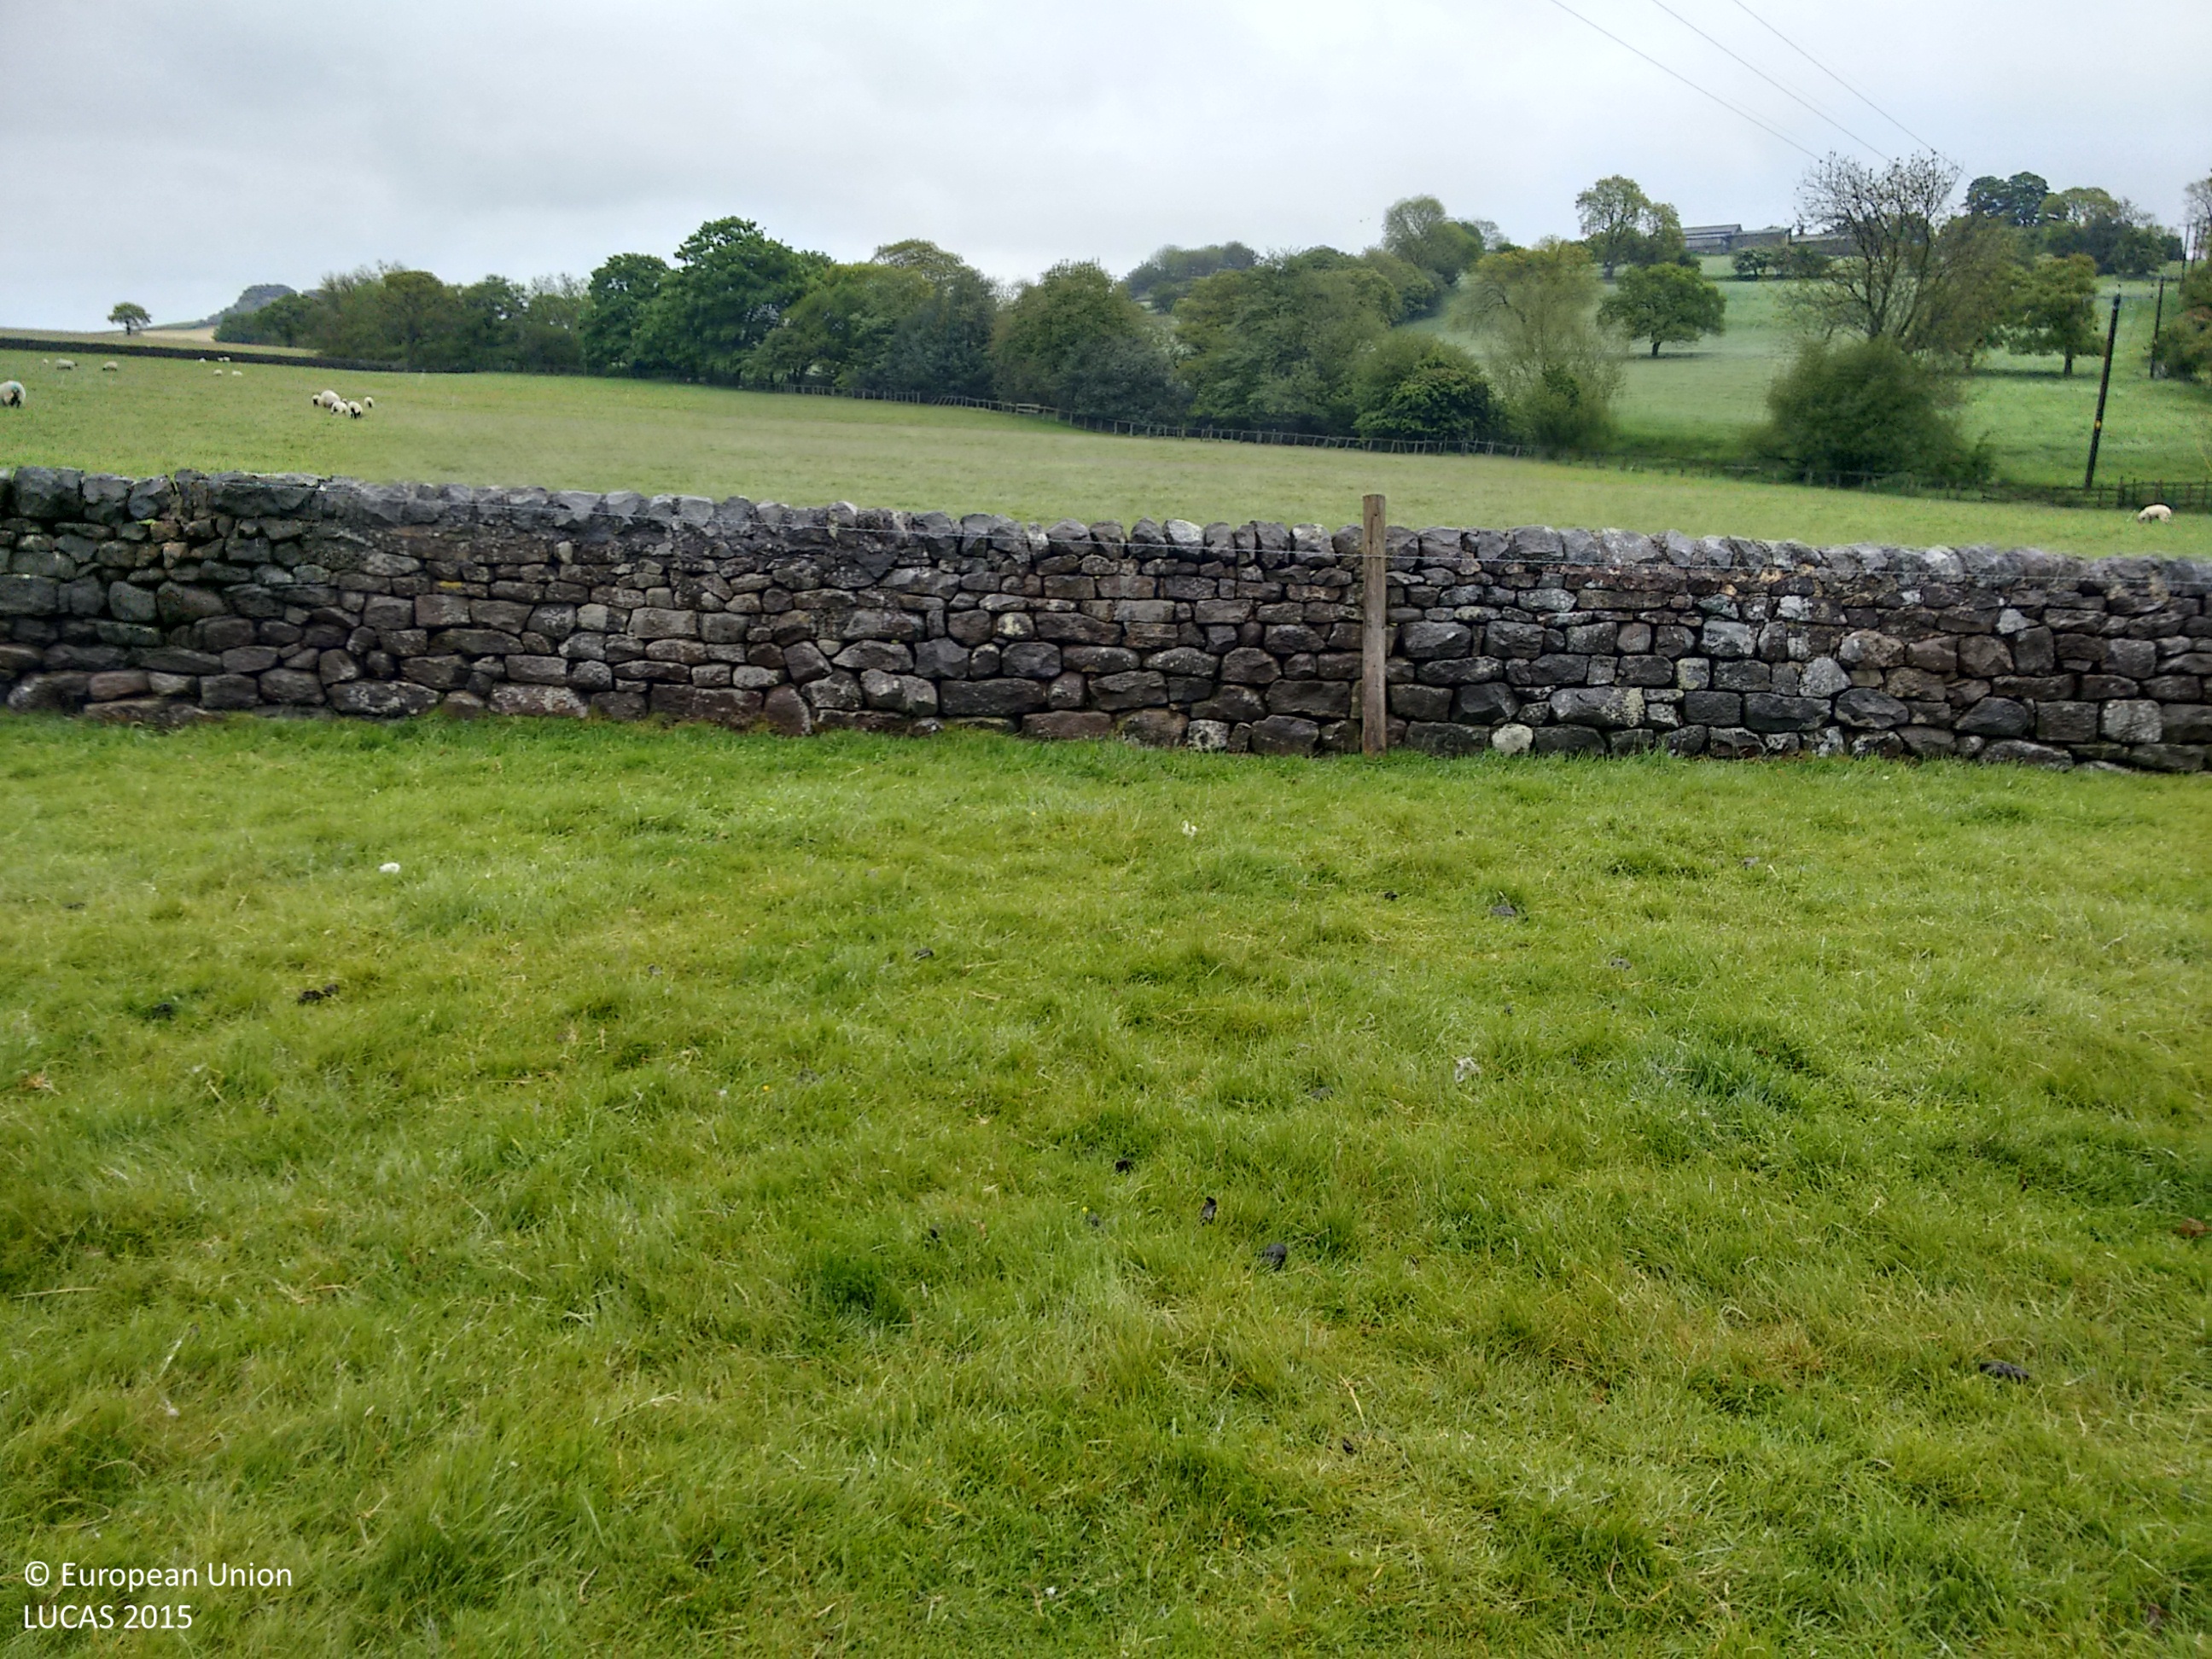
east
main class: Grassland
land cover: Grassland without tree/shrub cover
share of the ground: > 75 %
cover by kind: herbaceous plants 100 %
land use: Agriculture (excluding fallow land and kitchen gardens)
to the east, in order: Grassland without tree/shrub cover; Dry stone walls; Fences; Grassland without tree/shrub cover; Managed hedges; Rivers and streams; Managed hedges; Grassland without tree/shrub cover
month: May
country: GB
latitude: 53.9316
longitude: -1.6111
